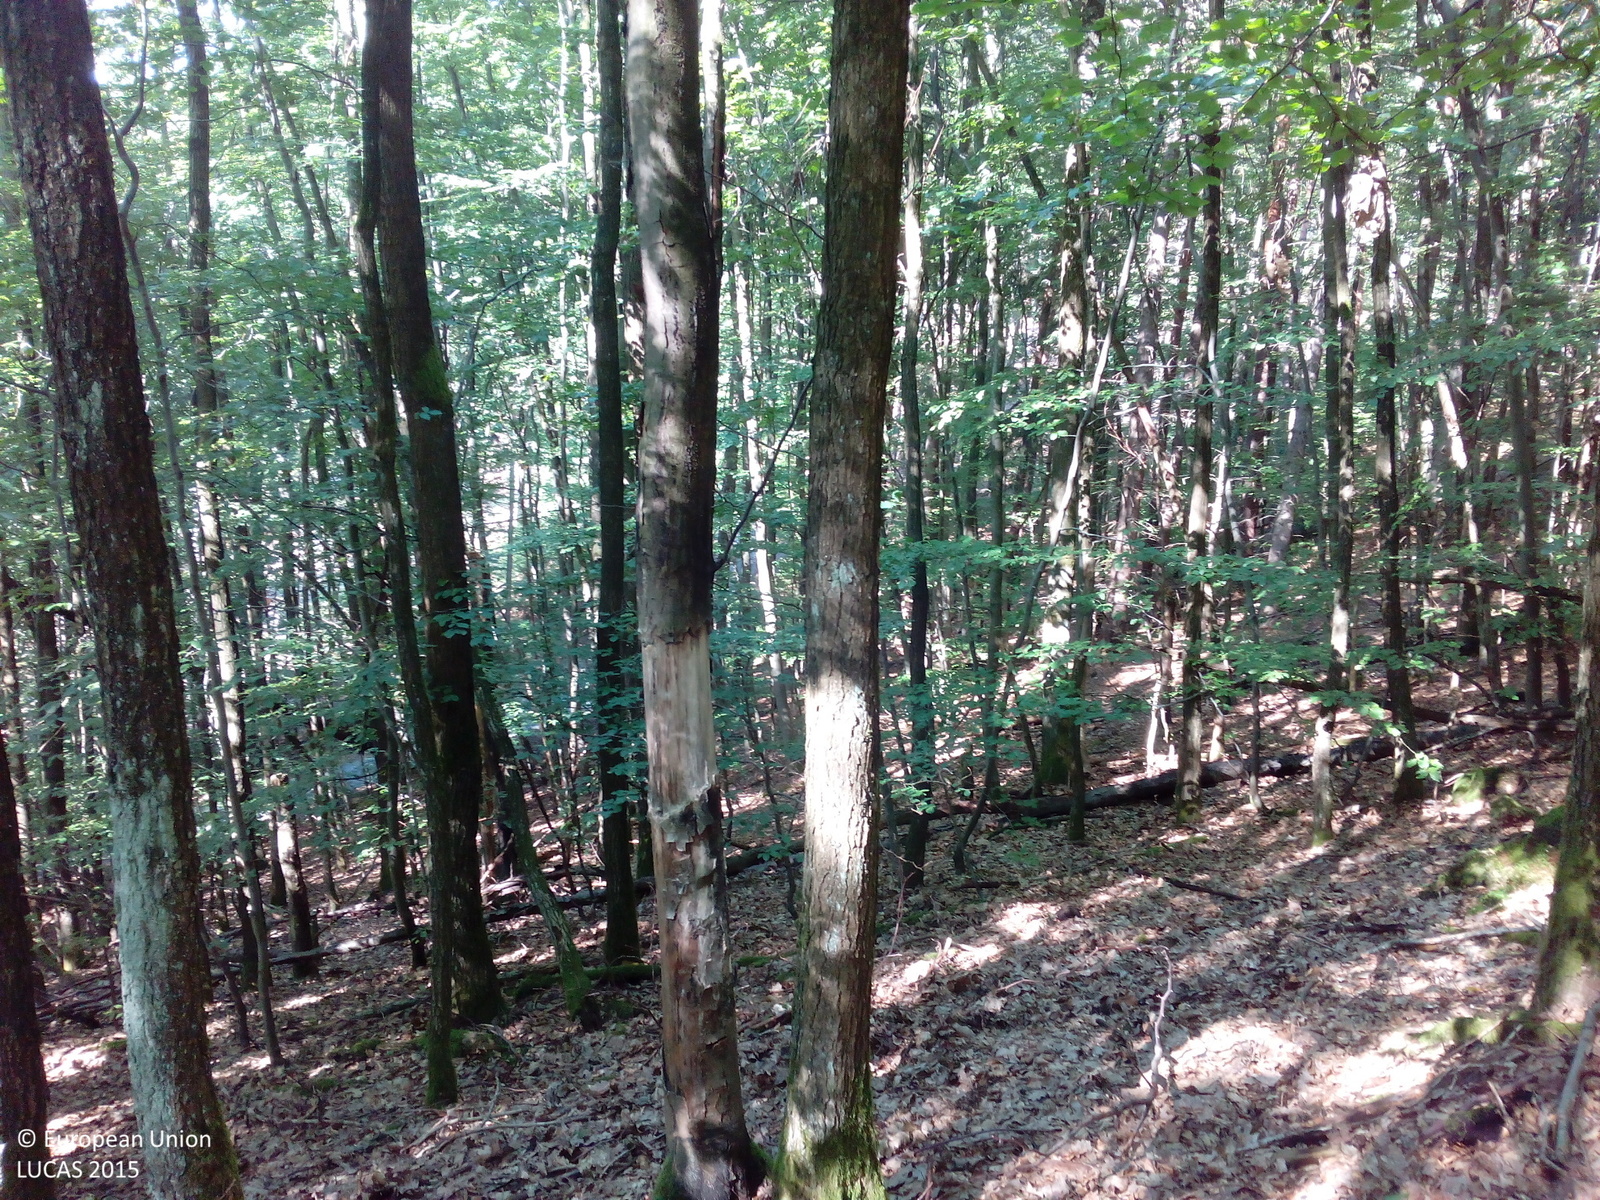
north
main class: Woodland
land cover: Broadleaved woodland
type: acidophilous oak and oak-birch forest
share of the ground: > 75 %
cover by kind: broadleaved forest trees 90 %, unconsolidated bare surface 10 %
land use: Forestry
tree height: > 5 m
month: September
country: DE
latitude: 49.8410
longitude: 9.4023
